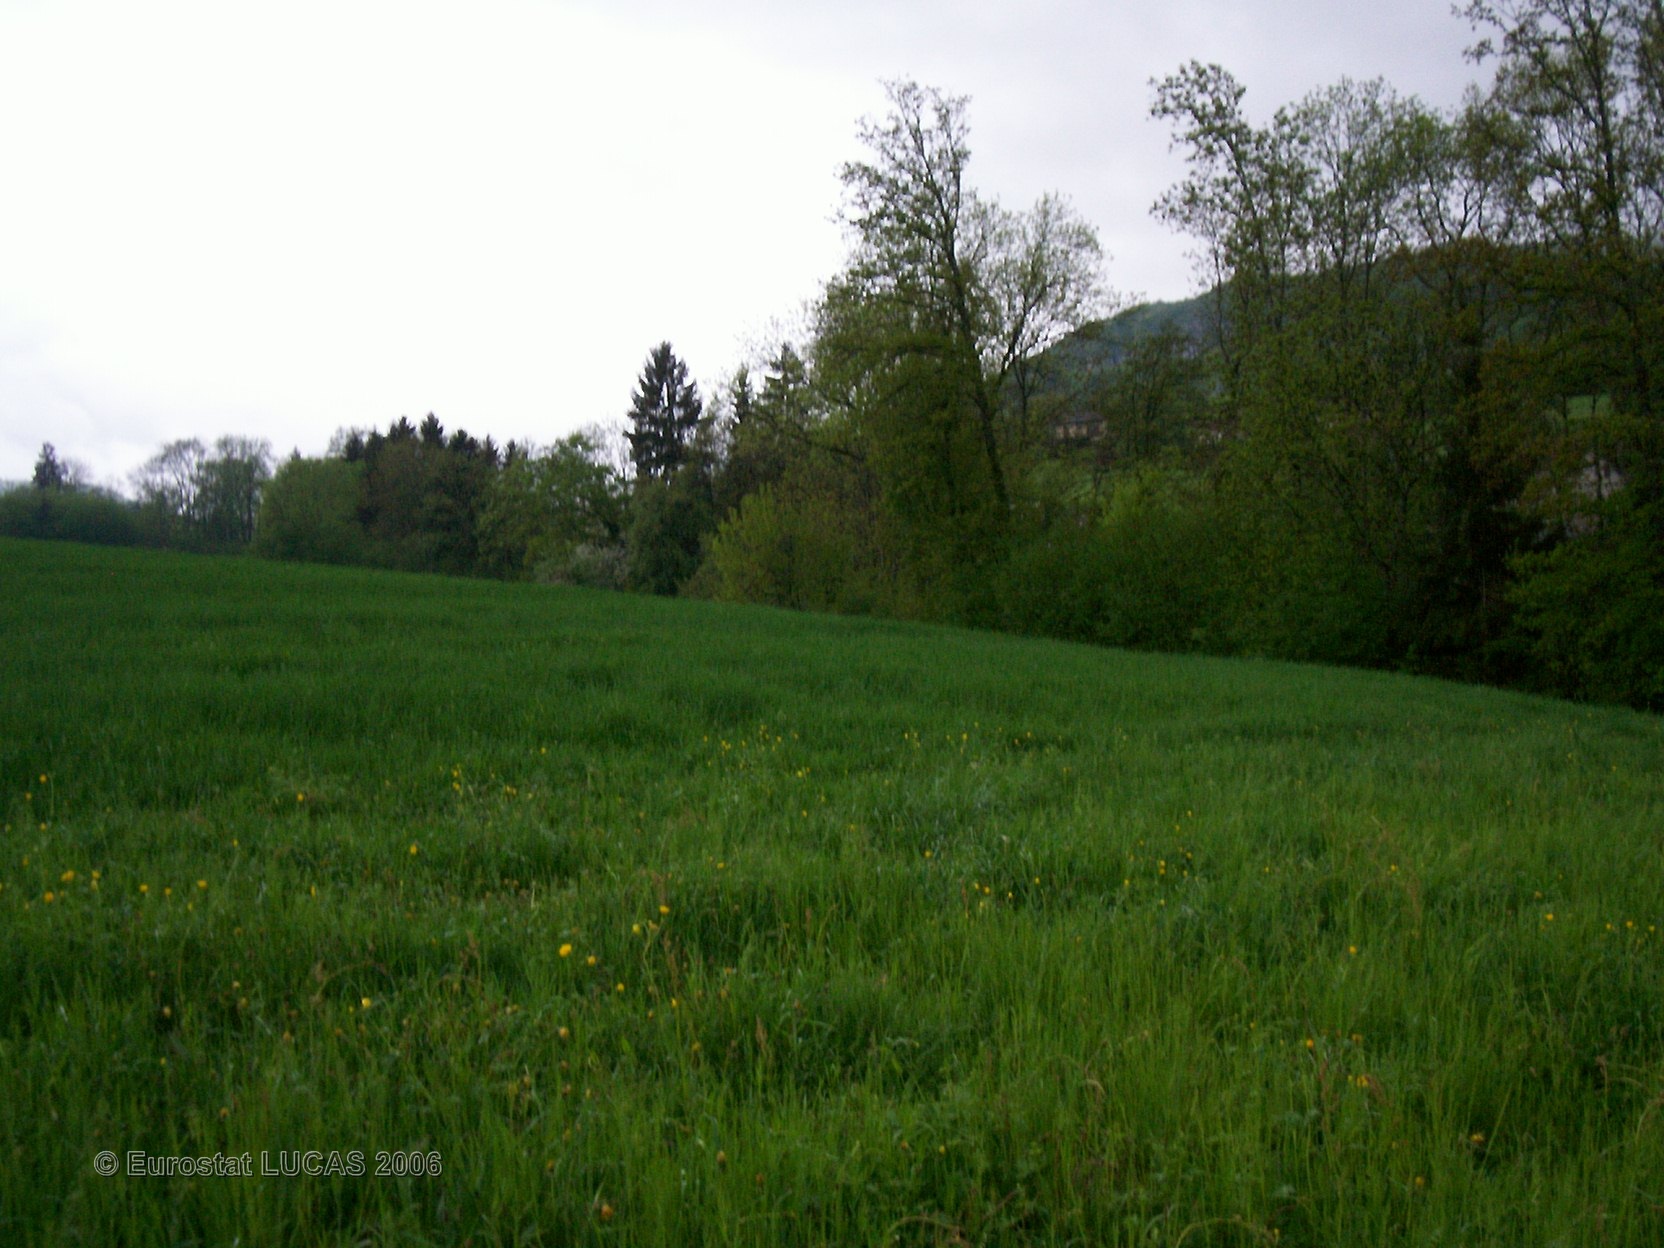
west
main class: Grassland
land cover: Grassland without tree/shrub cover
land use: Agriculture (excluding fallow land and kitchen gardens)
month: May
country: FR
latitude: 45.9922
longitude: 6.1177
